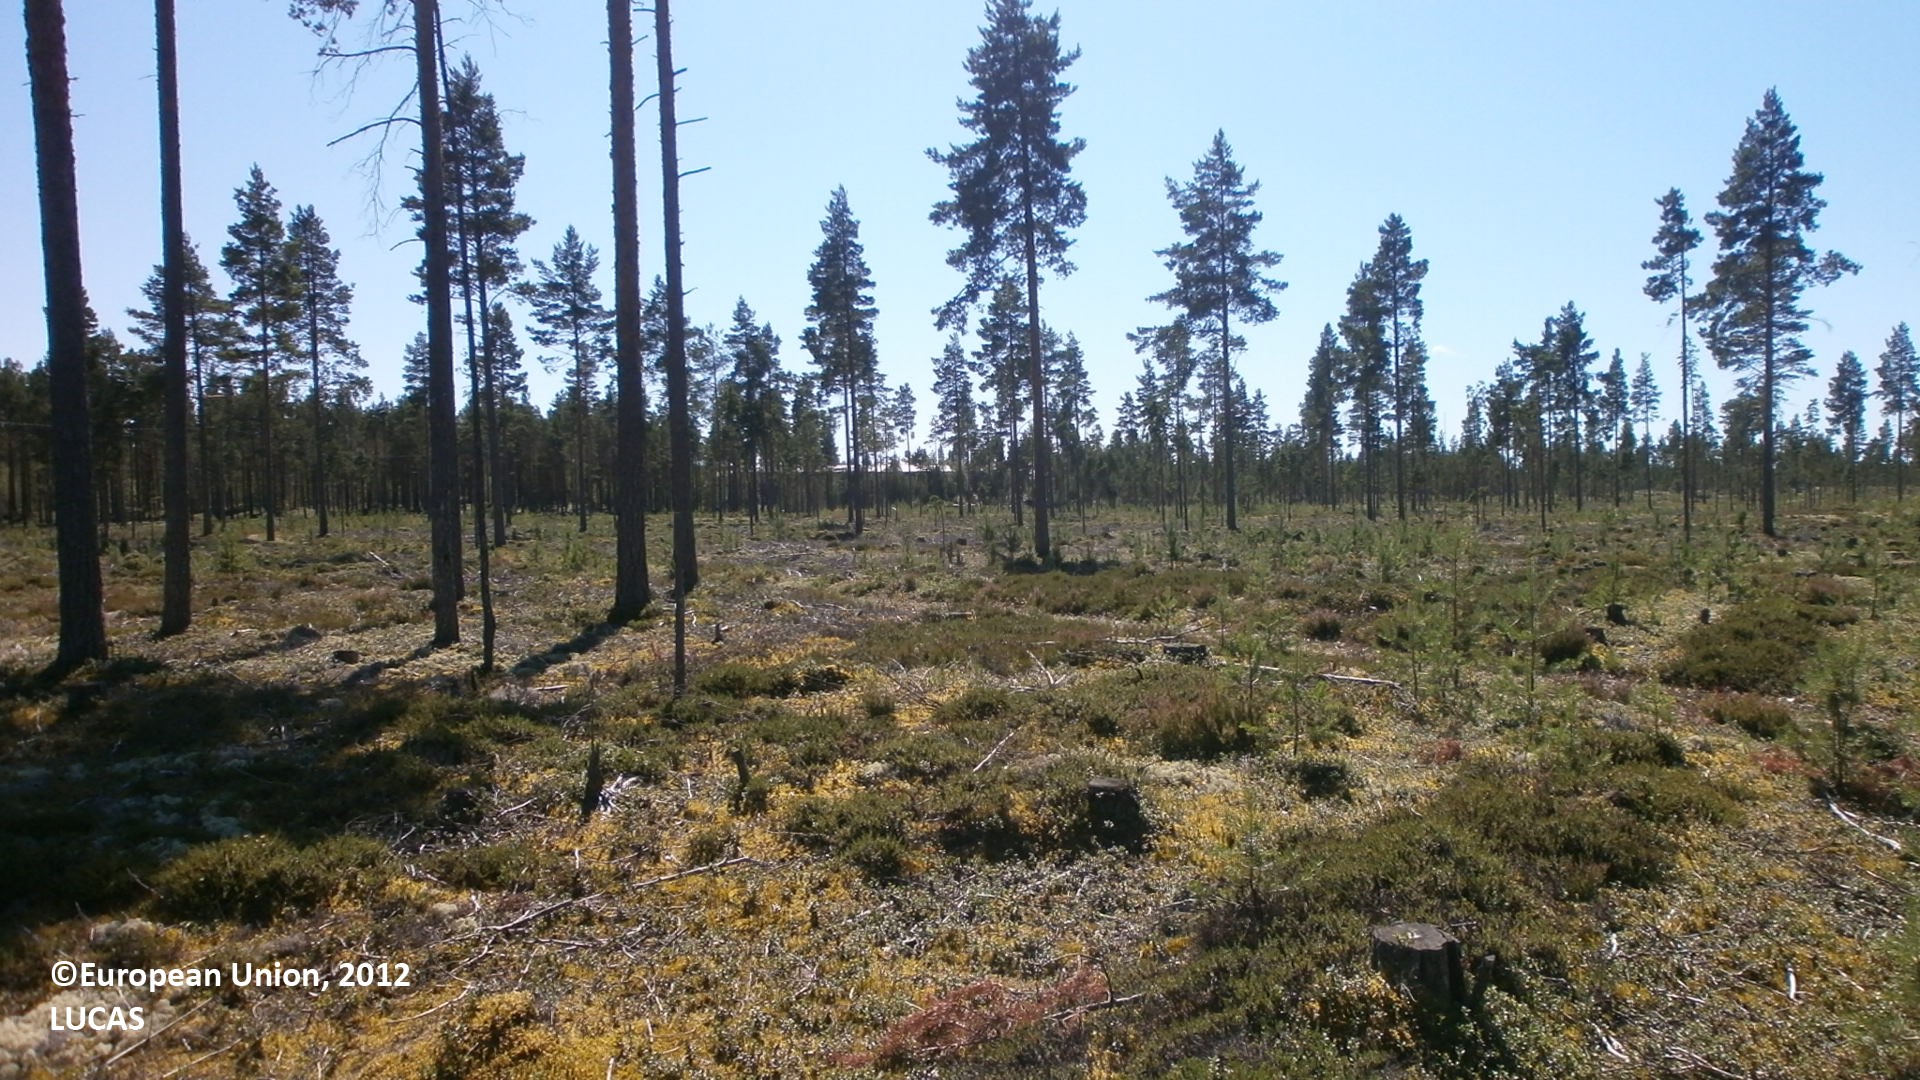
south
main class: Woodland
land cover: Pine dominated coniferous woodland
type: boreal forest
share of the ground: 10 - 25 %
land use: Forestry
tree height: > 5 m
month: July
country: FI
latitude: 64.1579
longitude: 23.8165
